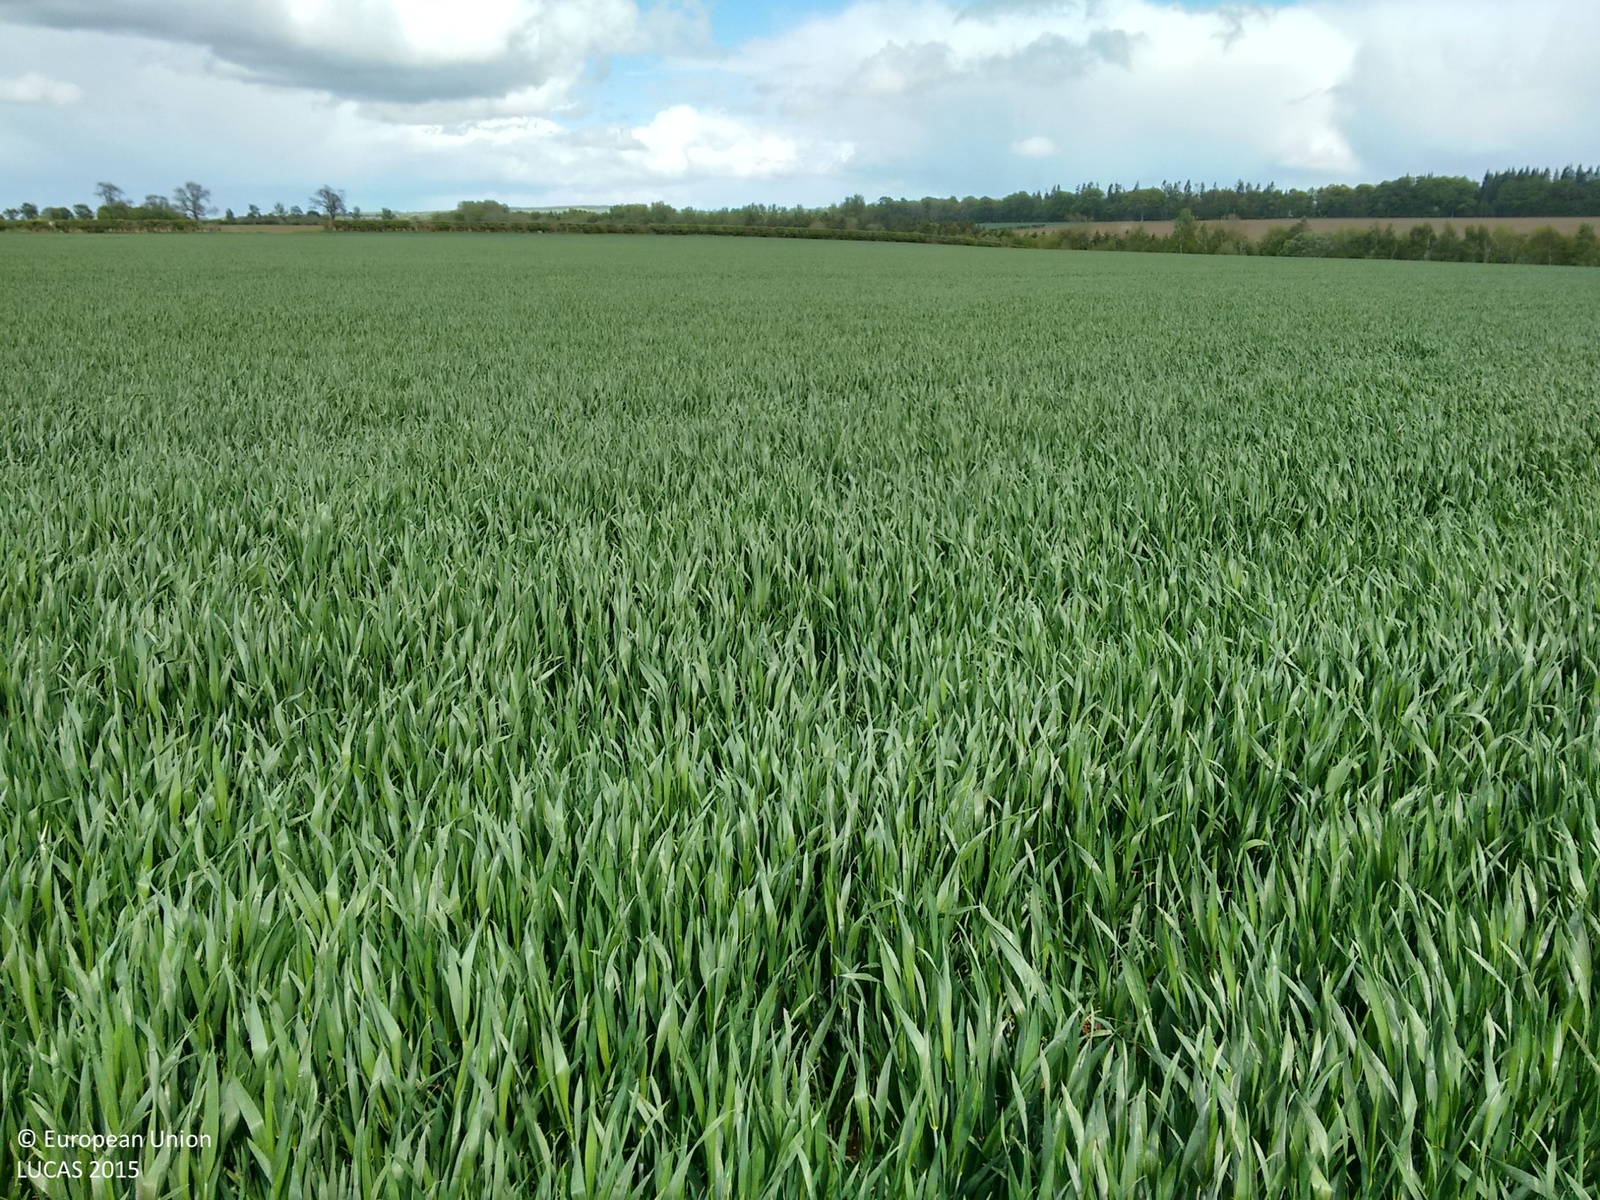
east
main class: Cropland
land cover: Barley
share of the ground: > 75 %
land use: Agriculture (excluding fallow land and kitchen gardens)
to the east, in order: Barley
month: May
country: GB
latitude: 55.5786
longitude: -2.4484
